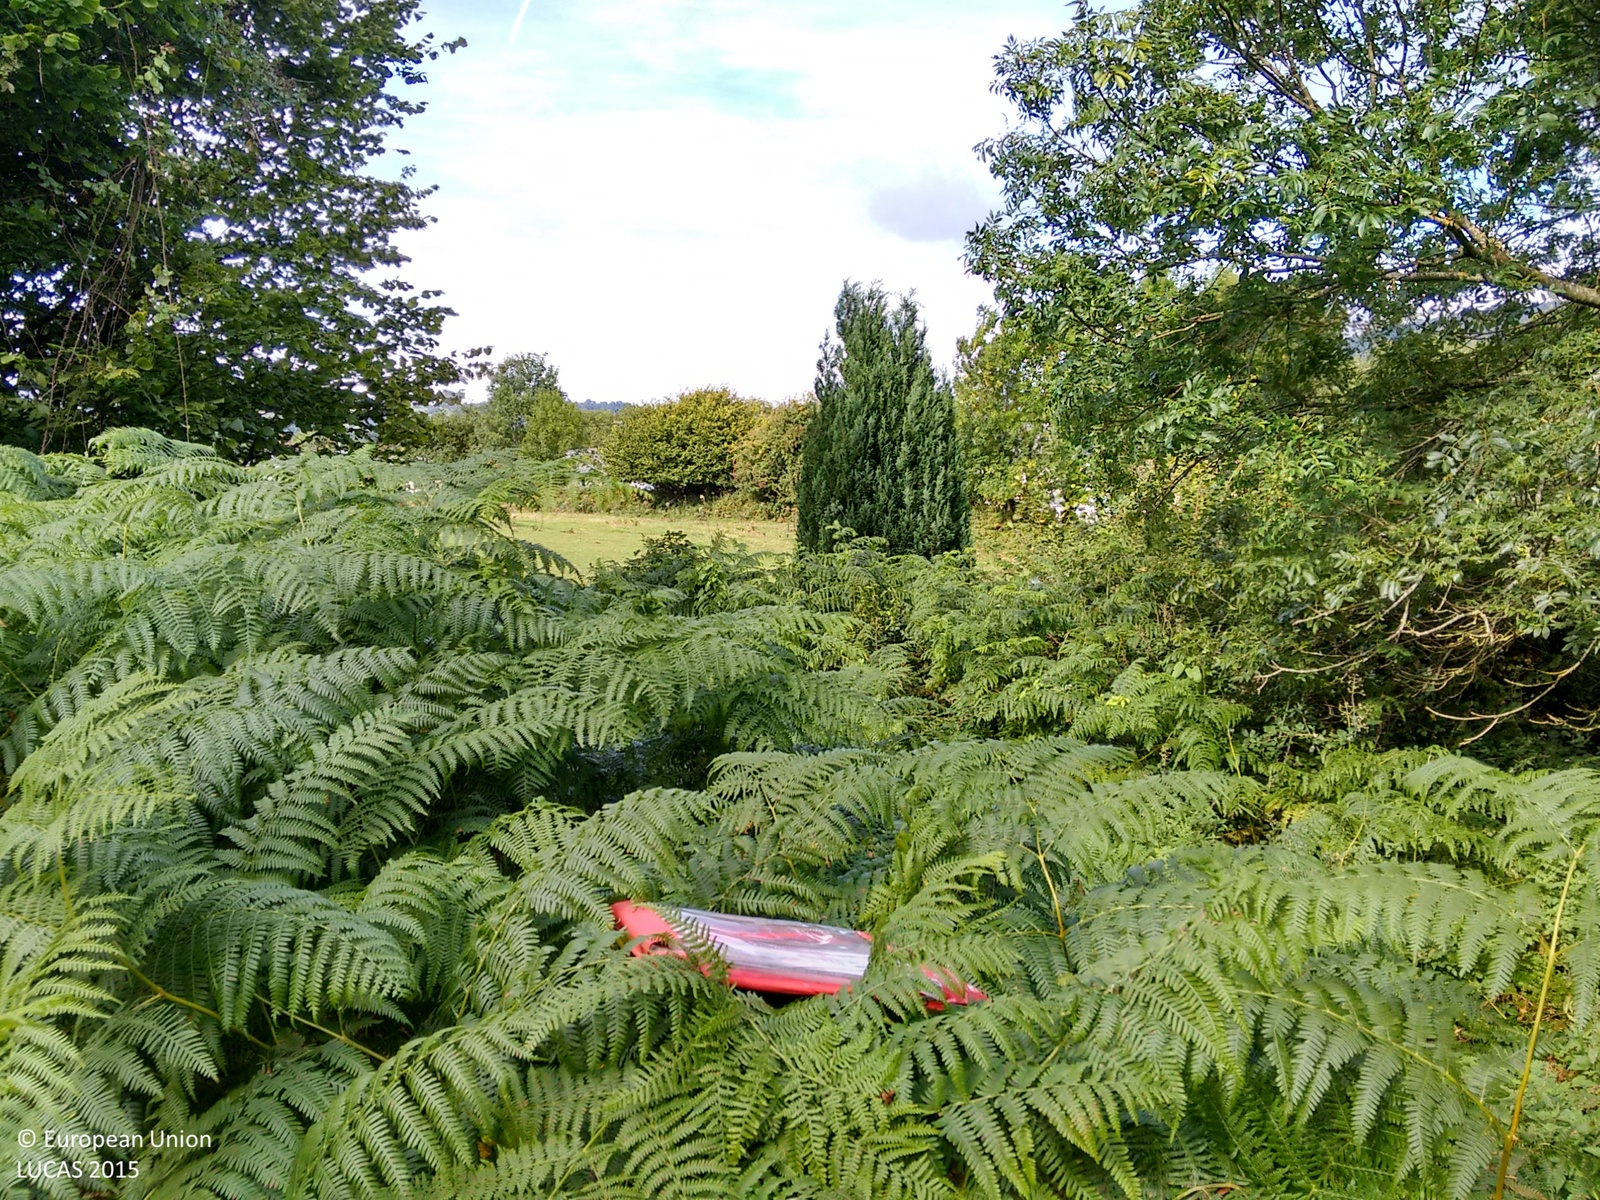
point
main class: Grassland
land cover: Grassland with sparse tree/shrub cover
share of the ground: > 75 %
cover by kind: herbaceous plants 95 %, broadleaved forest trees 5 %
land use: Semi-natural and natural areas not in use
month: September
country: GB
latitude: 51.8160
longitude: -3.0593
